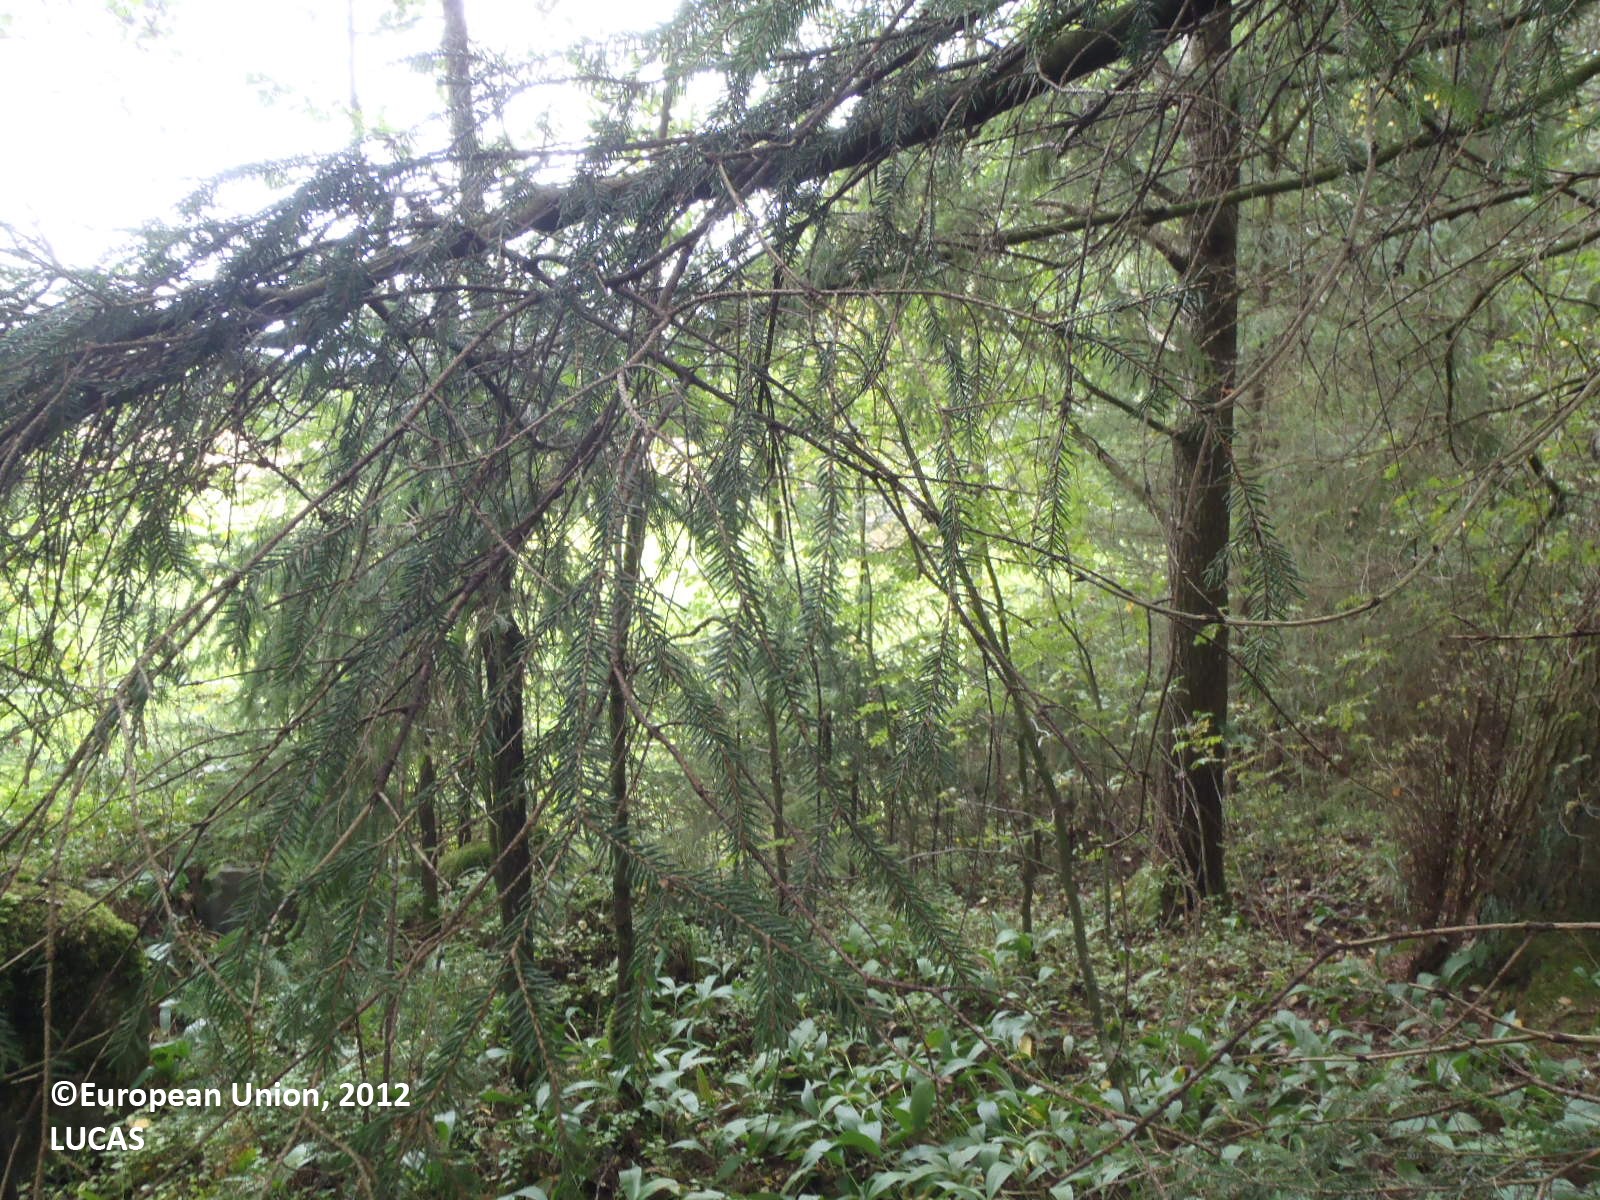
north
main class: Woodland
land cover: Spruce dominated coniferous woodland
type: boreal forest
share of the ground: > 75 %
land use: Forestry
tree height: > 5 m
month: August
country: FI
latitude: 60.7161
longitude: 21.8815
